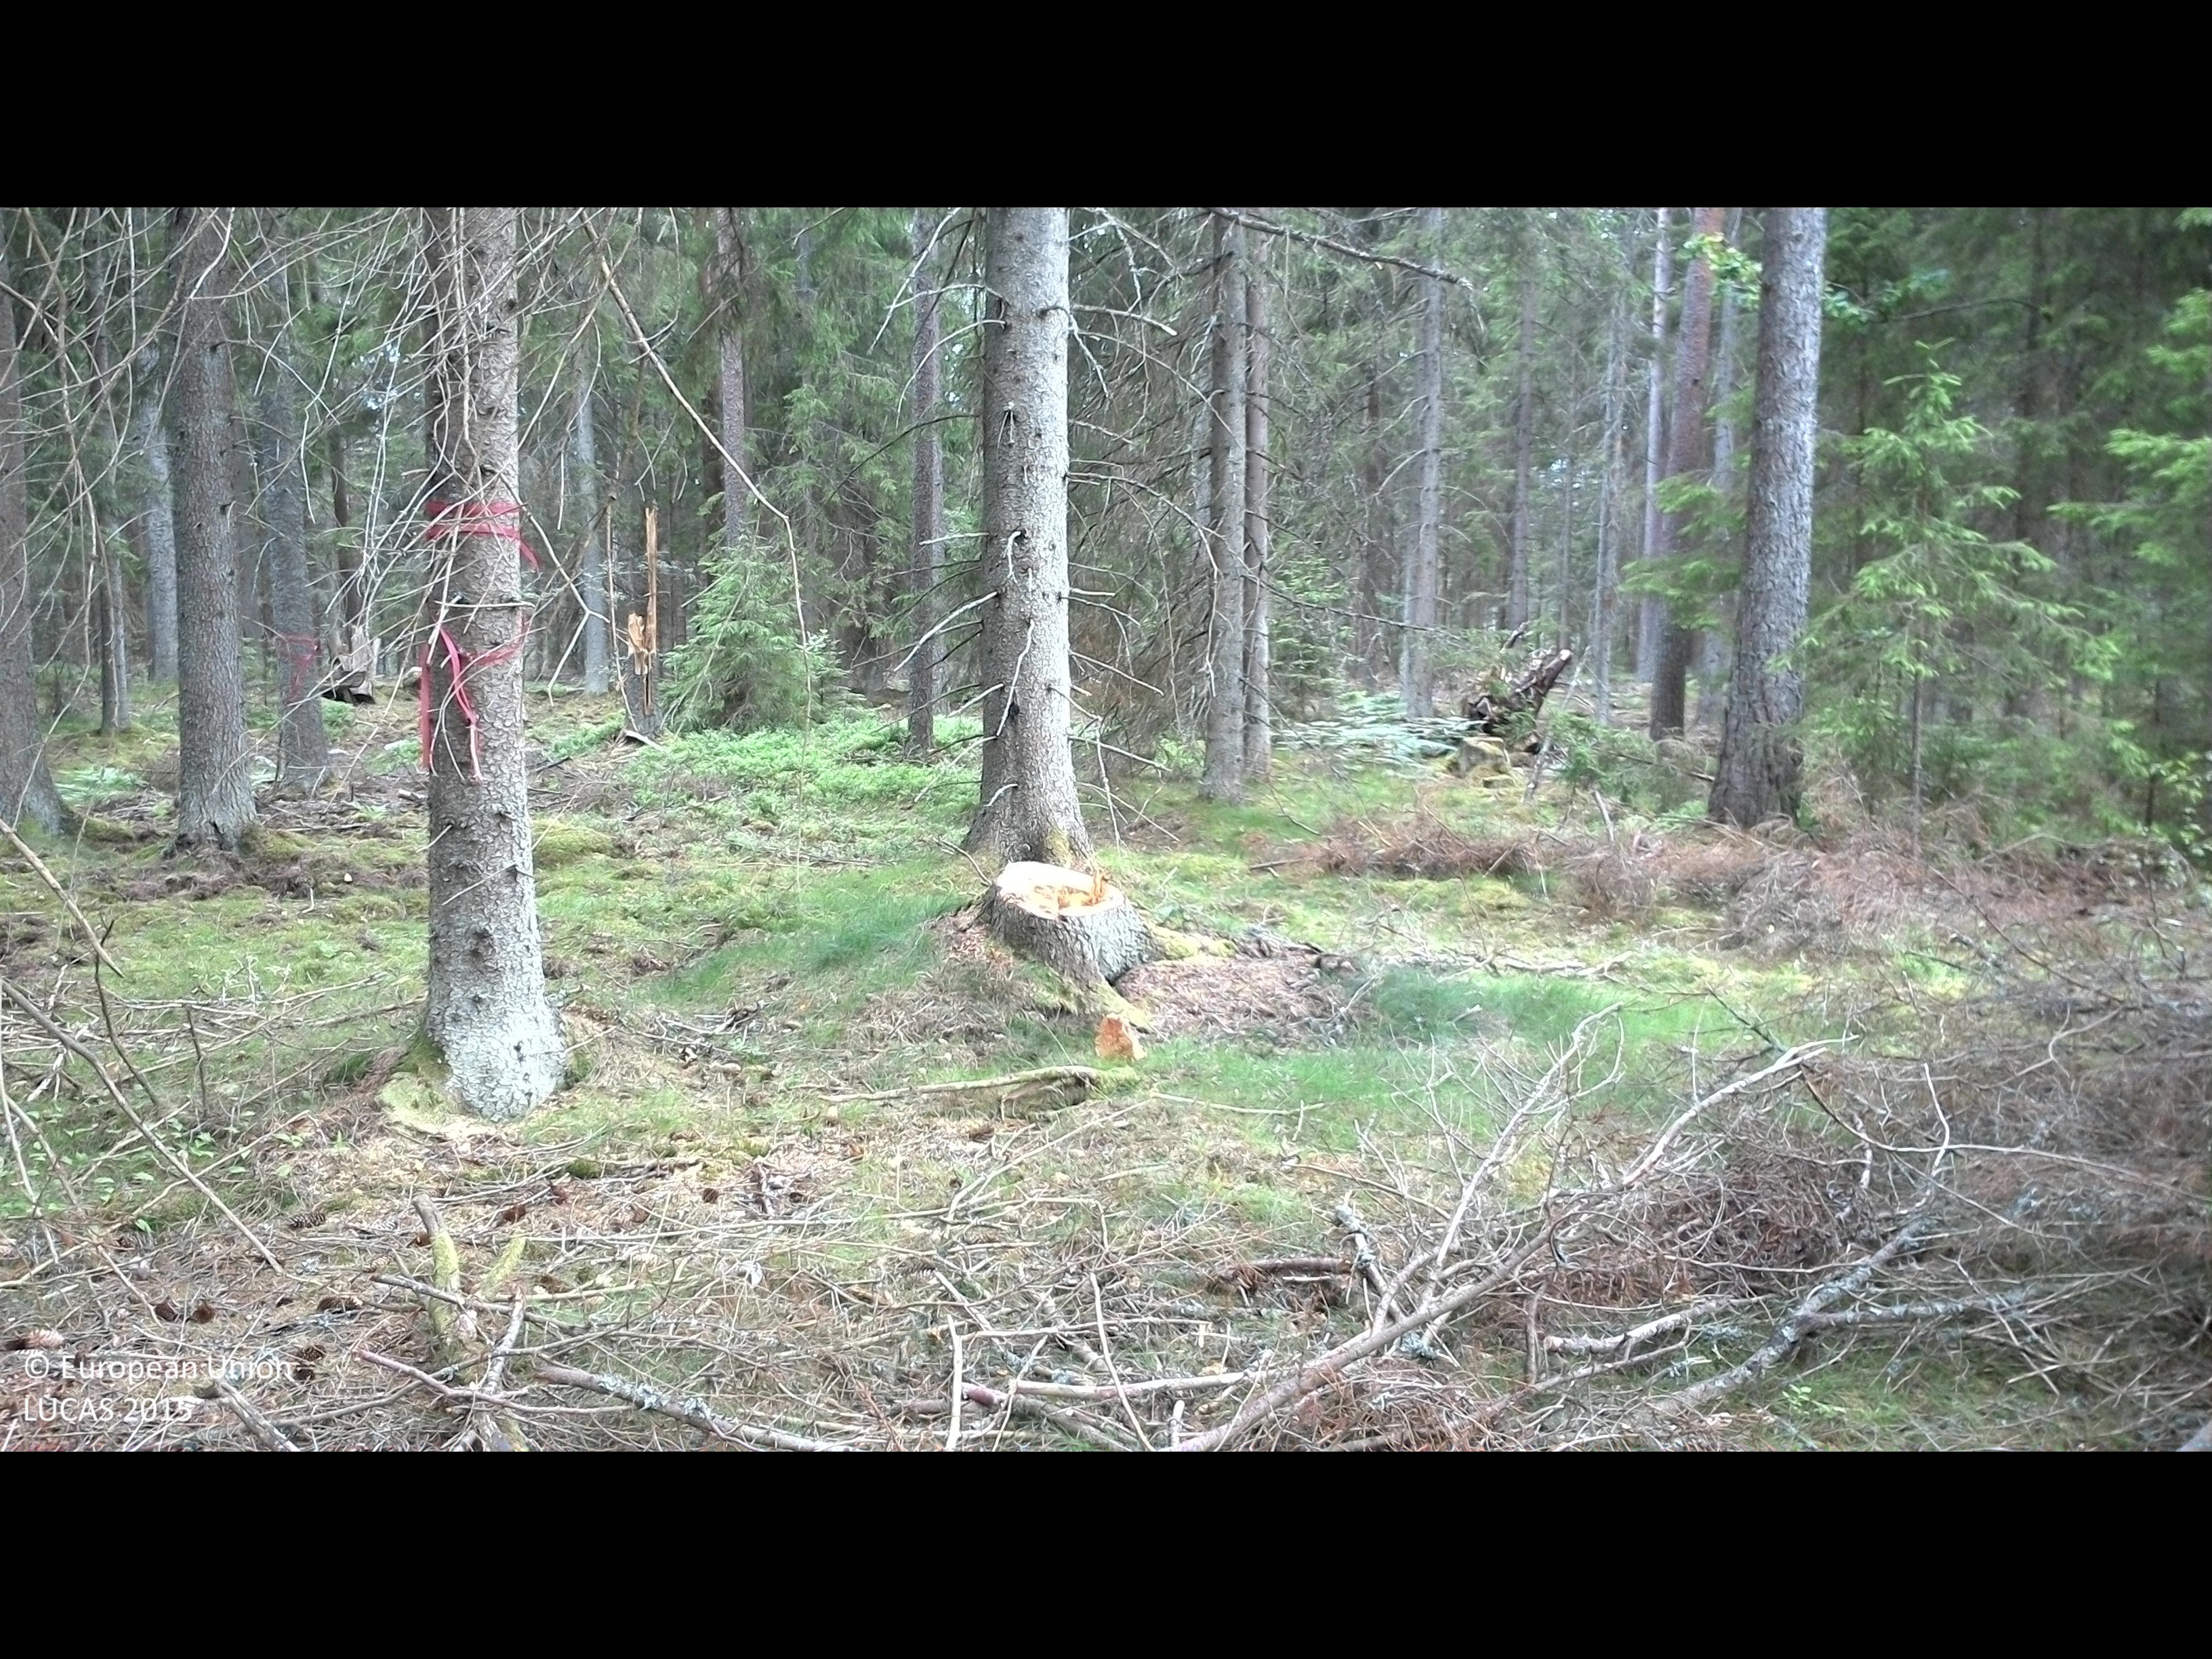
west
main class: Woodland
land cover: Spruce dominated coniferous woodland
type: boreal forest
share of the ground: 50 - 75 %
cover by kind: coniferous forest trees 70 %, lichens and mosses 25 %, herbaceous plants 5 %
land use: Forestry
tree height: > 5 m
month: July
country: SE
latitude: 56.5150
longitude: 14.7270
